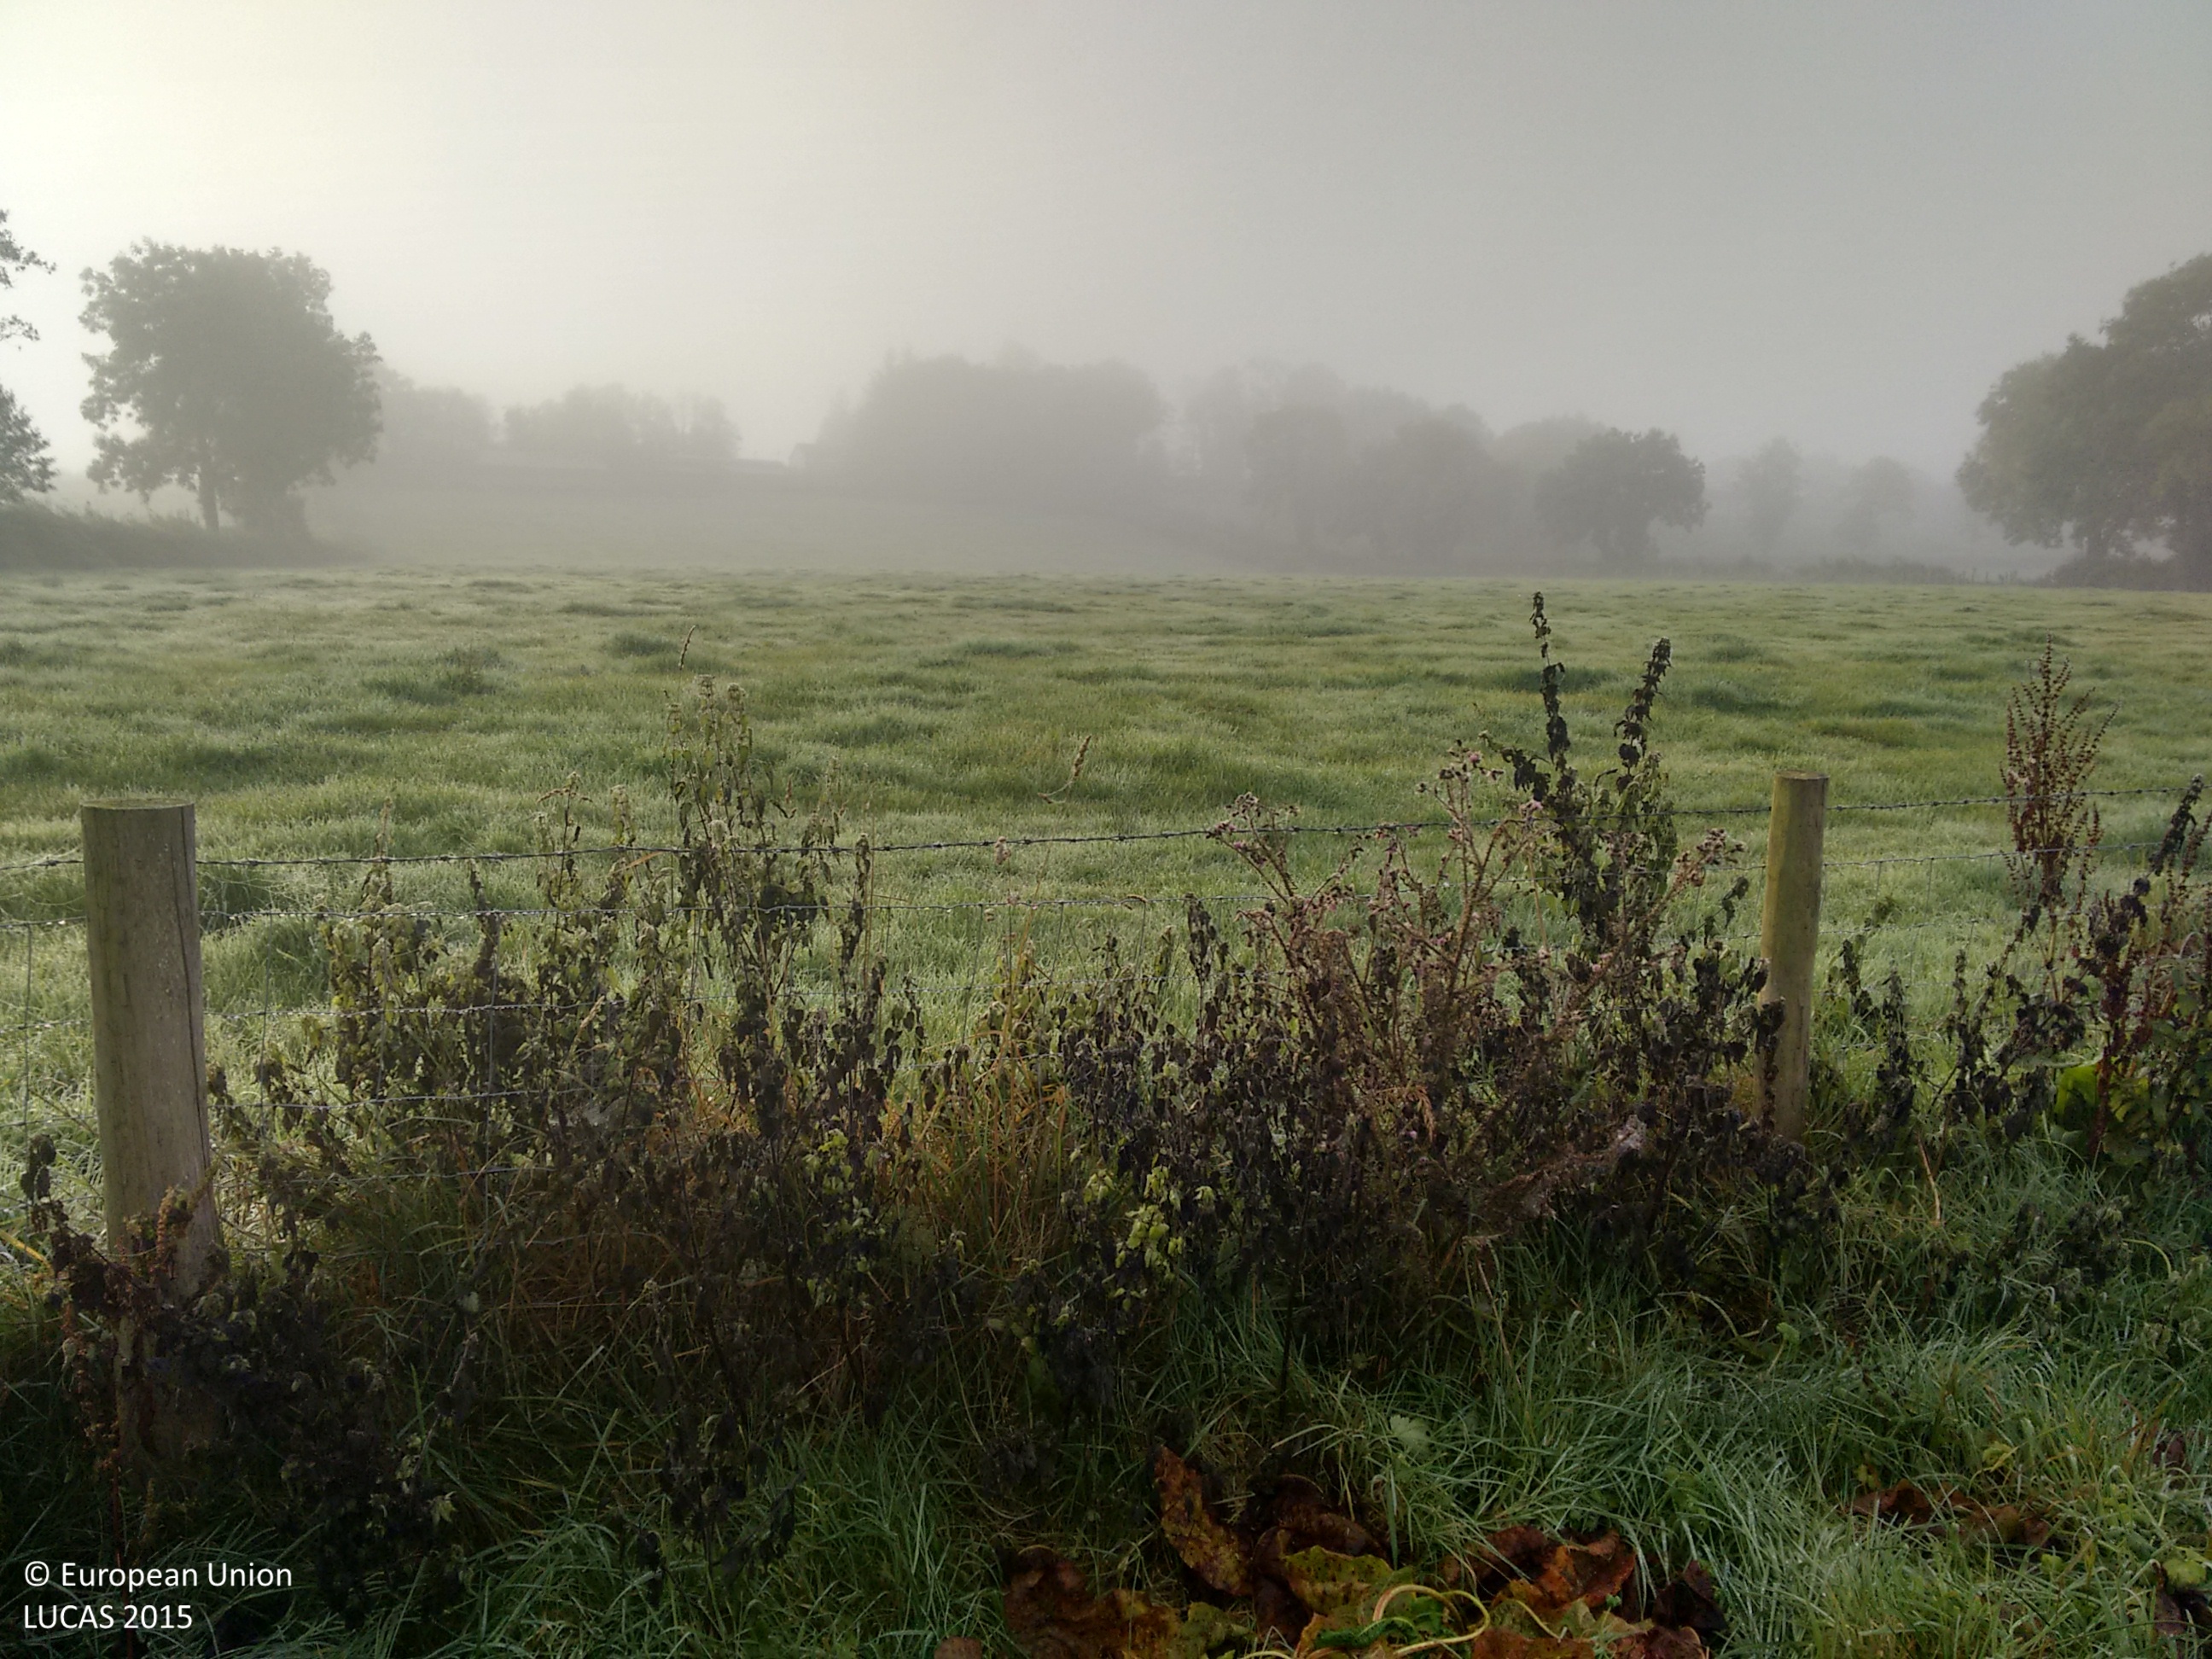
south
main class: Grassland
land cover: Grassland without tree/shrub cover
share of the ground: > 75 %
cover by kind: herbaceous plants 100 %
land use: Agriculture (excluding fallow land and kitchen gardens)
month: October
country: GB
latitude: 54.2878
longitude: -7.7543
